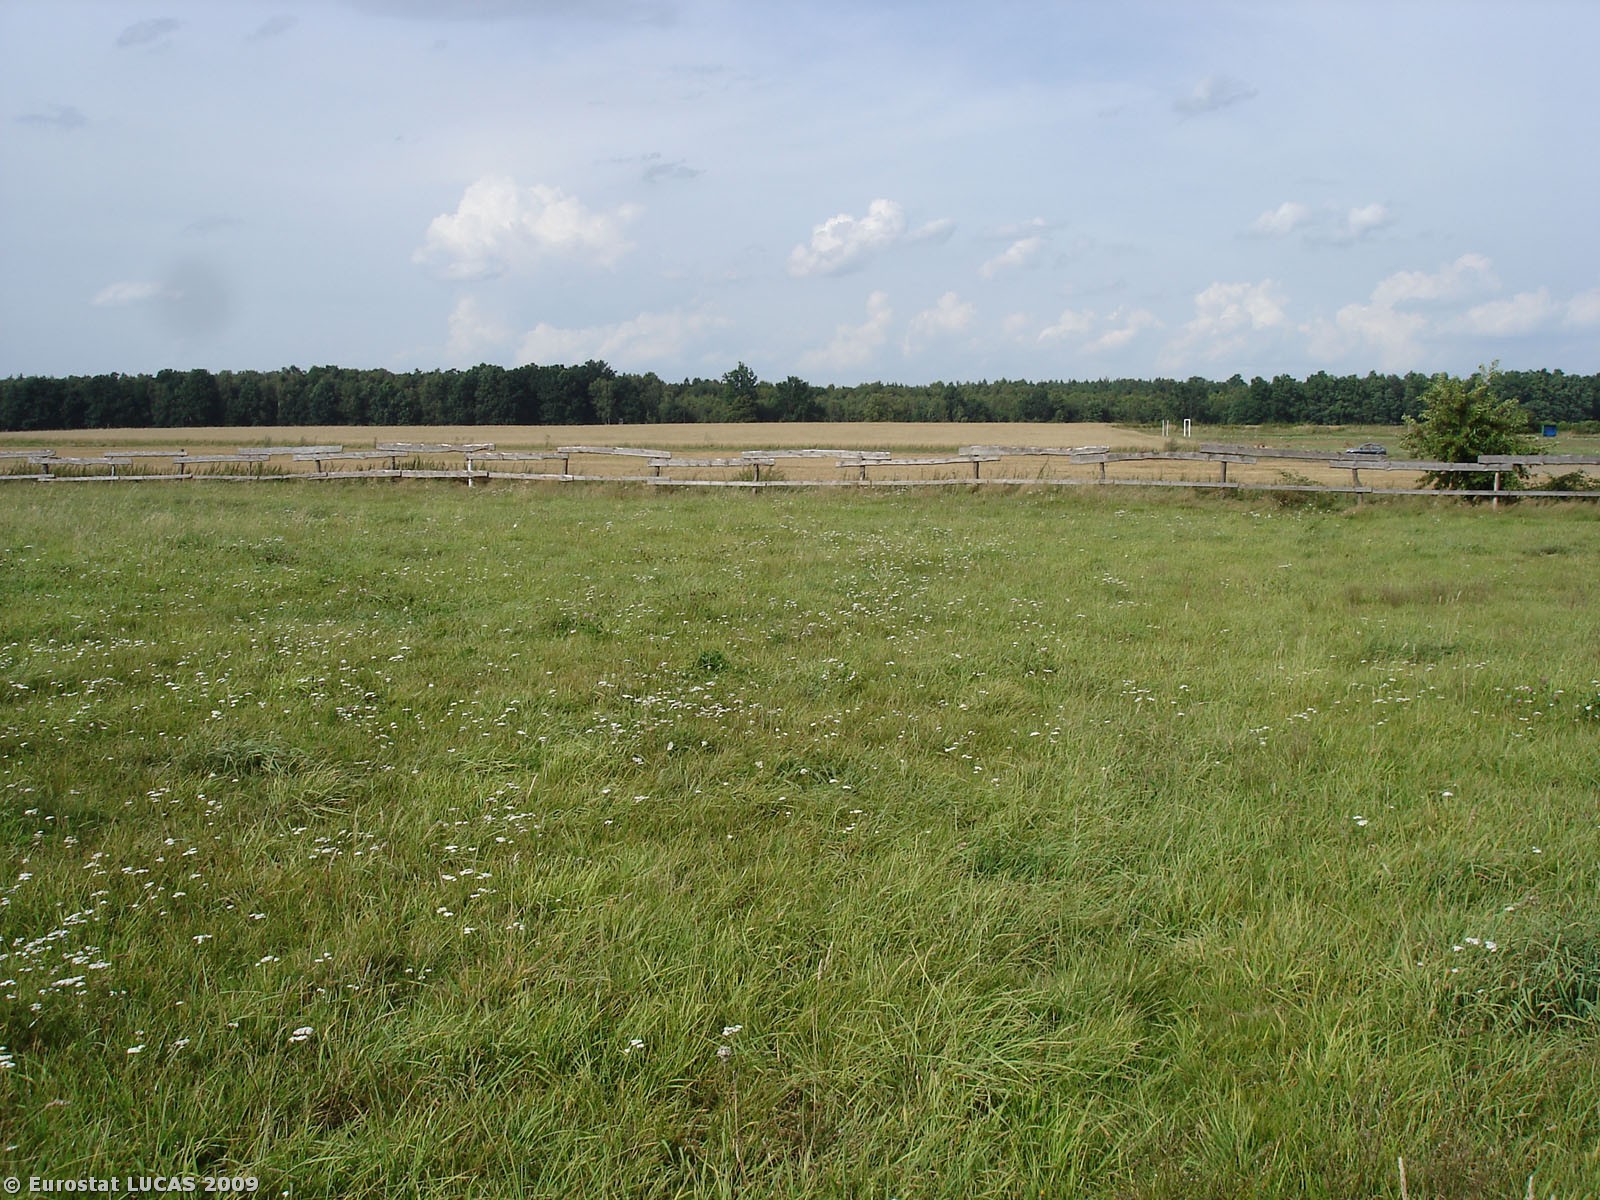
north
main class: Grassland
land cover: Grassland without tree/shrub cover
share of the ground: > 75 %
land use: Agriculture (excluding fallow land and kitchen gardens)
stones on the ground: < 10 %
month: August
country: PL
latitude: 50.7641
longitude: 18.3405
